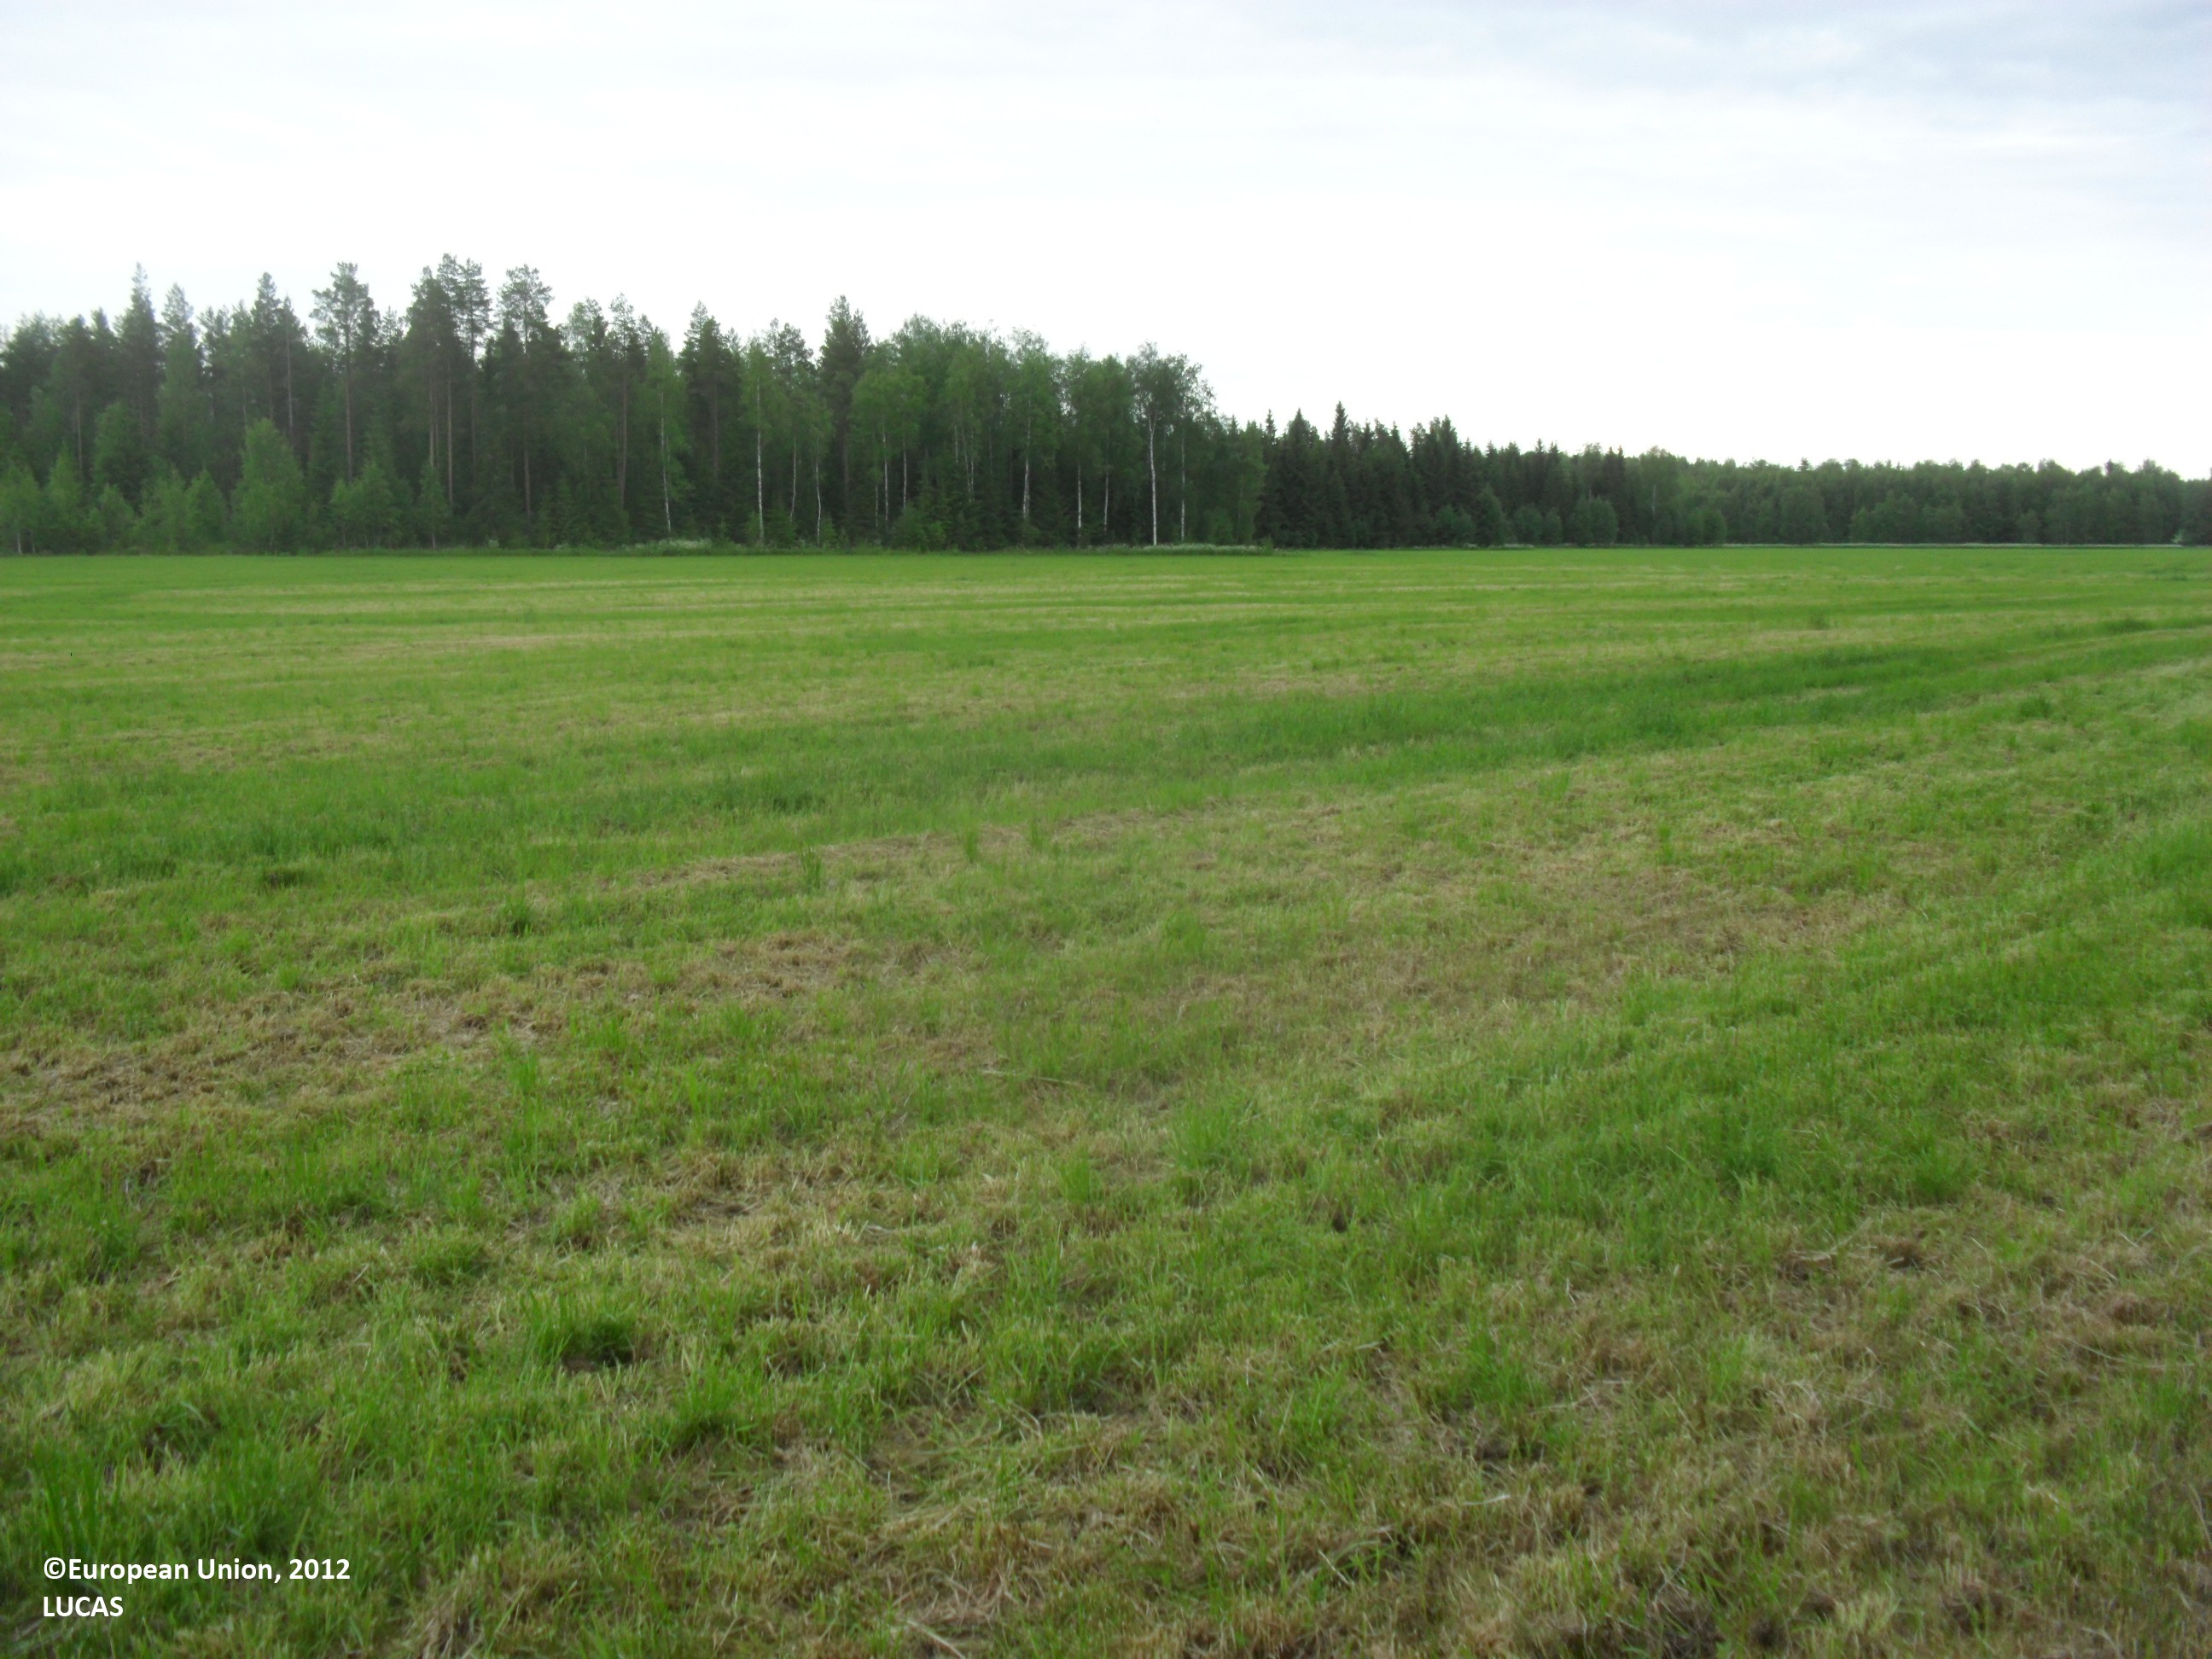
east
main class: Grassland
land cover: Grassland without tree/shrub cover
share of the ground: > 75 %
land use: Agriculture (excluding fallow land and kitchen gardens)
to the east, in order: Grassland without tree/shrub cover; Temporary grasslands; Ditches and canals; Temporary grasslands; Ditches and canals; Other mixed woodland
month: June
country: FI
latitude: 63.4831
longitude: 23.1257
